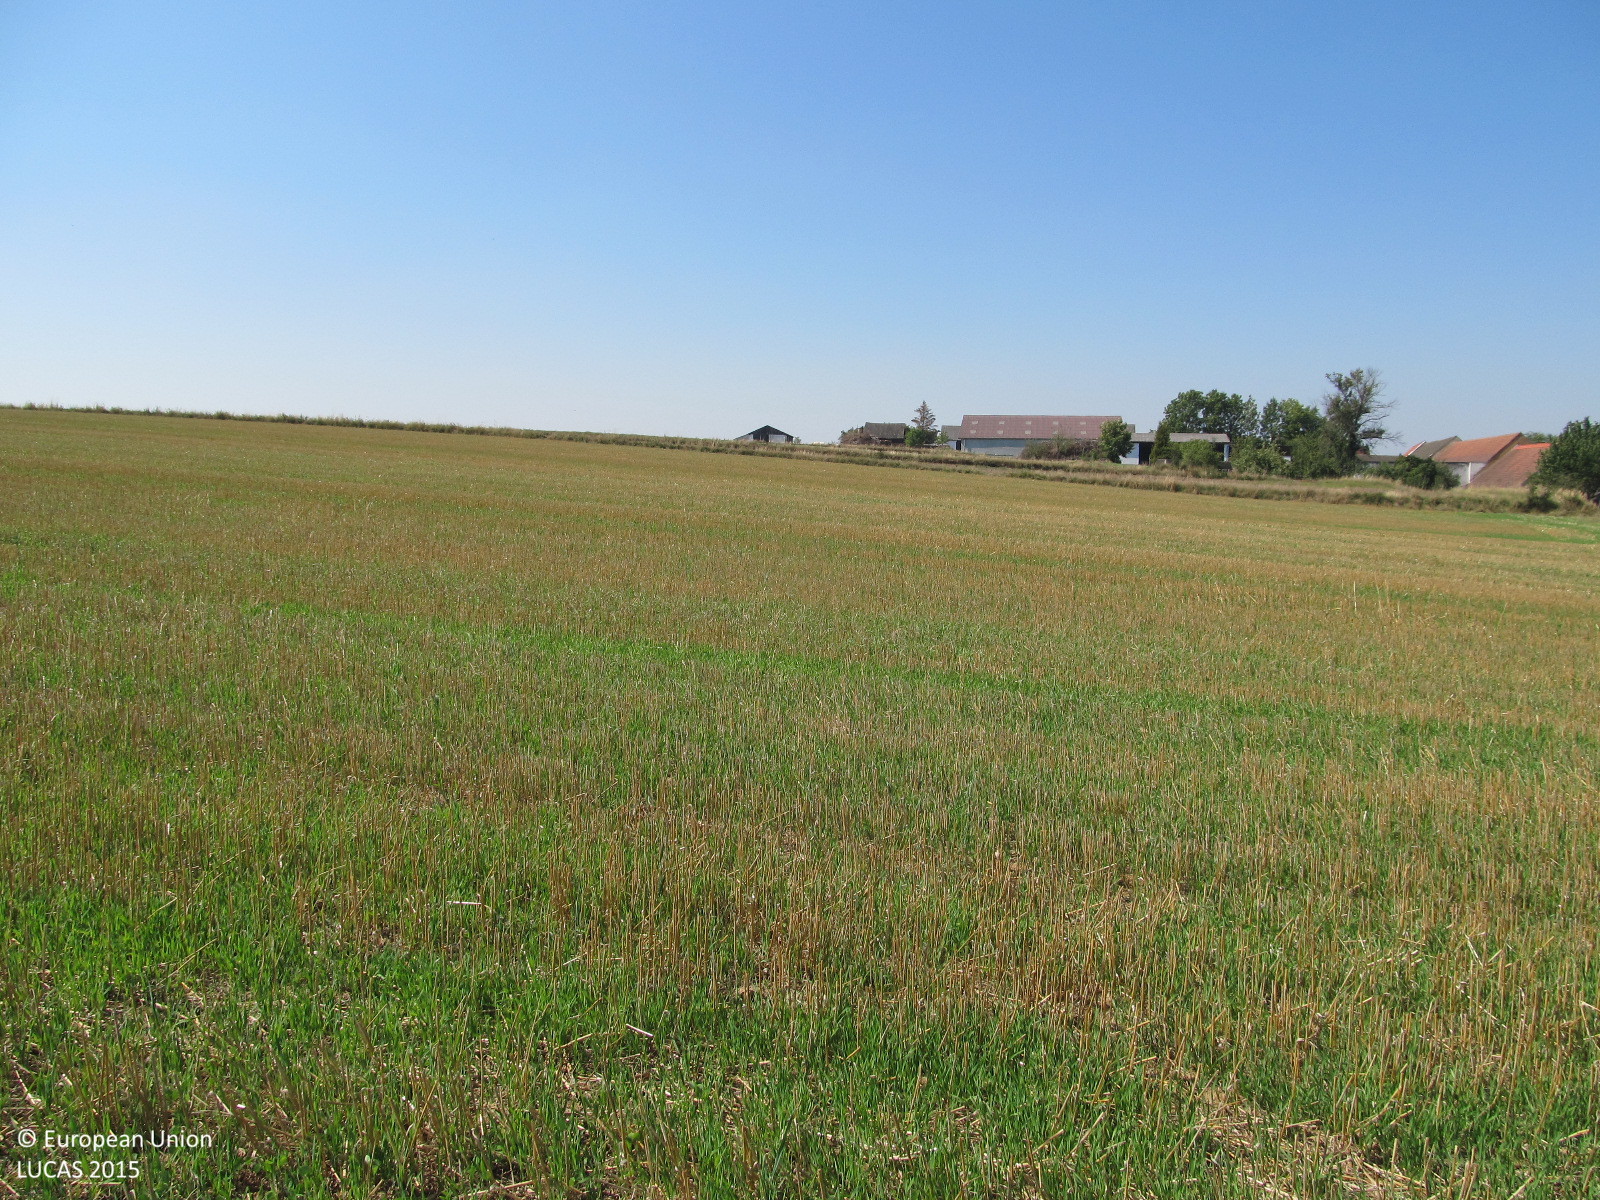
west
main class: Cropland
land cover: Common wheat
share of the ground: 50 - 75 %
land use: Agriculture (excluding fallow land and kitchen gardens)
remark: Harvested field
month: August
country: AT
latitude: 48.8260
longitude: 15.4926
